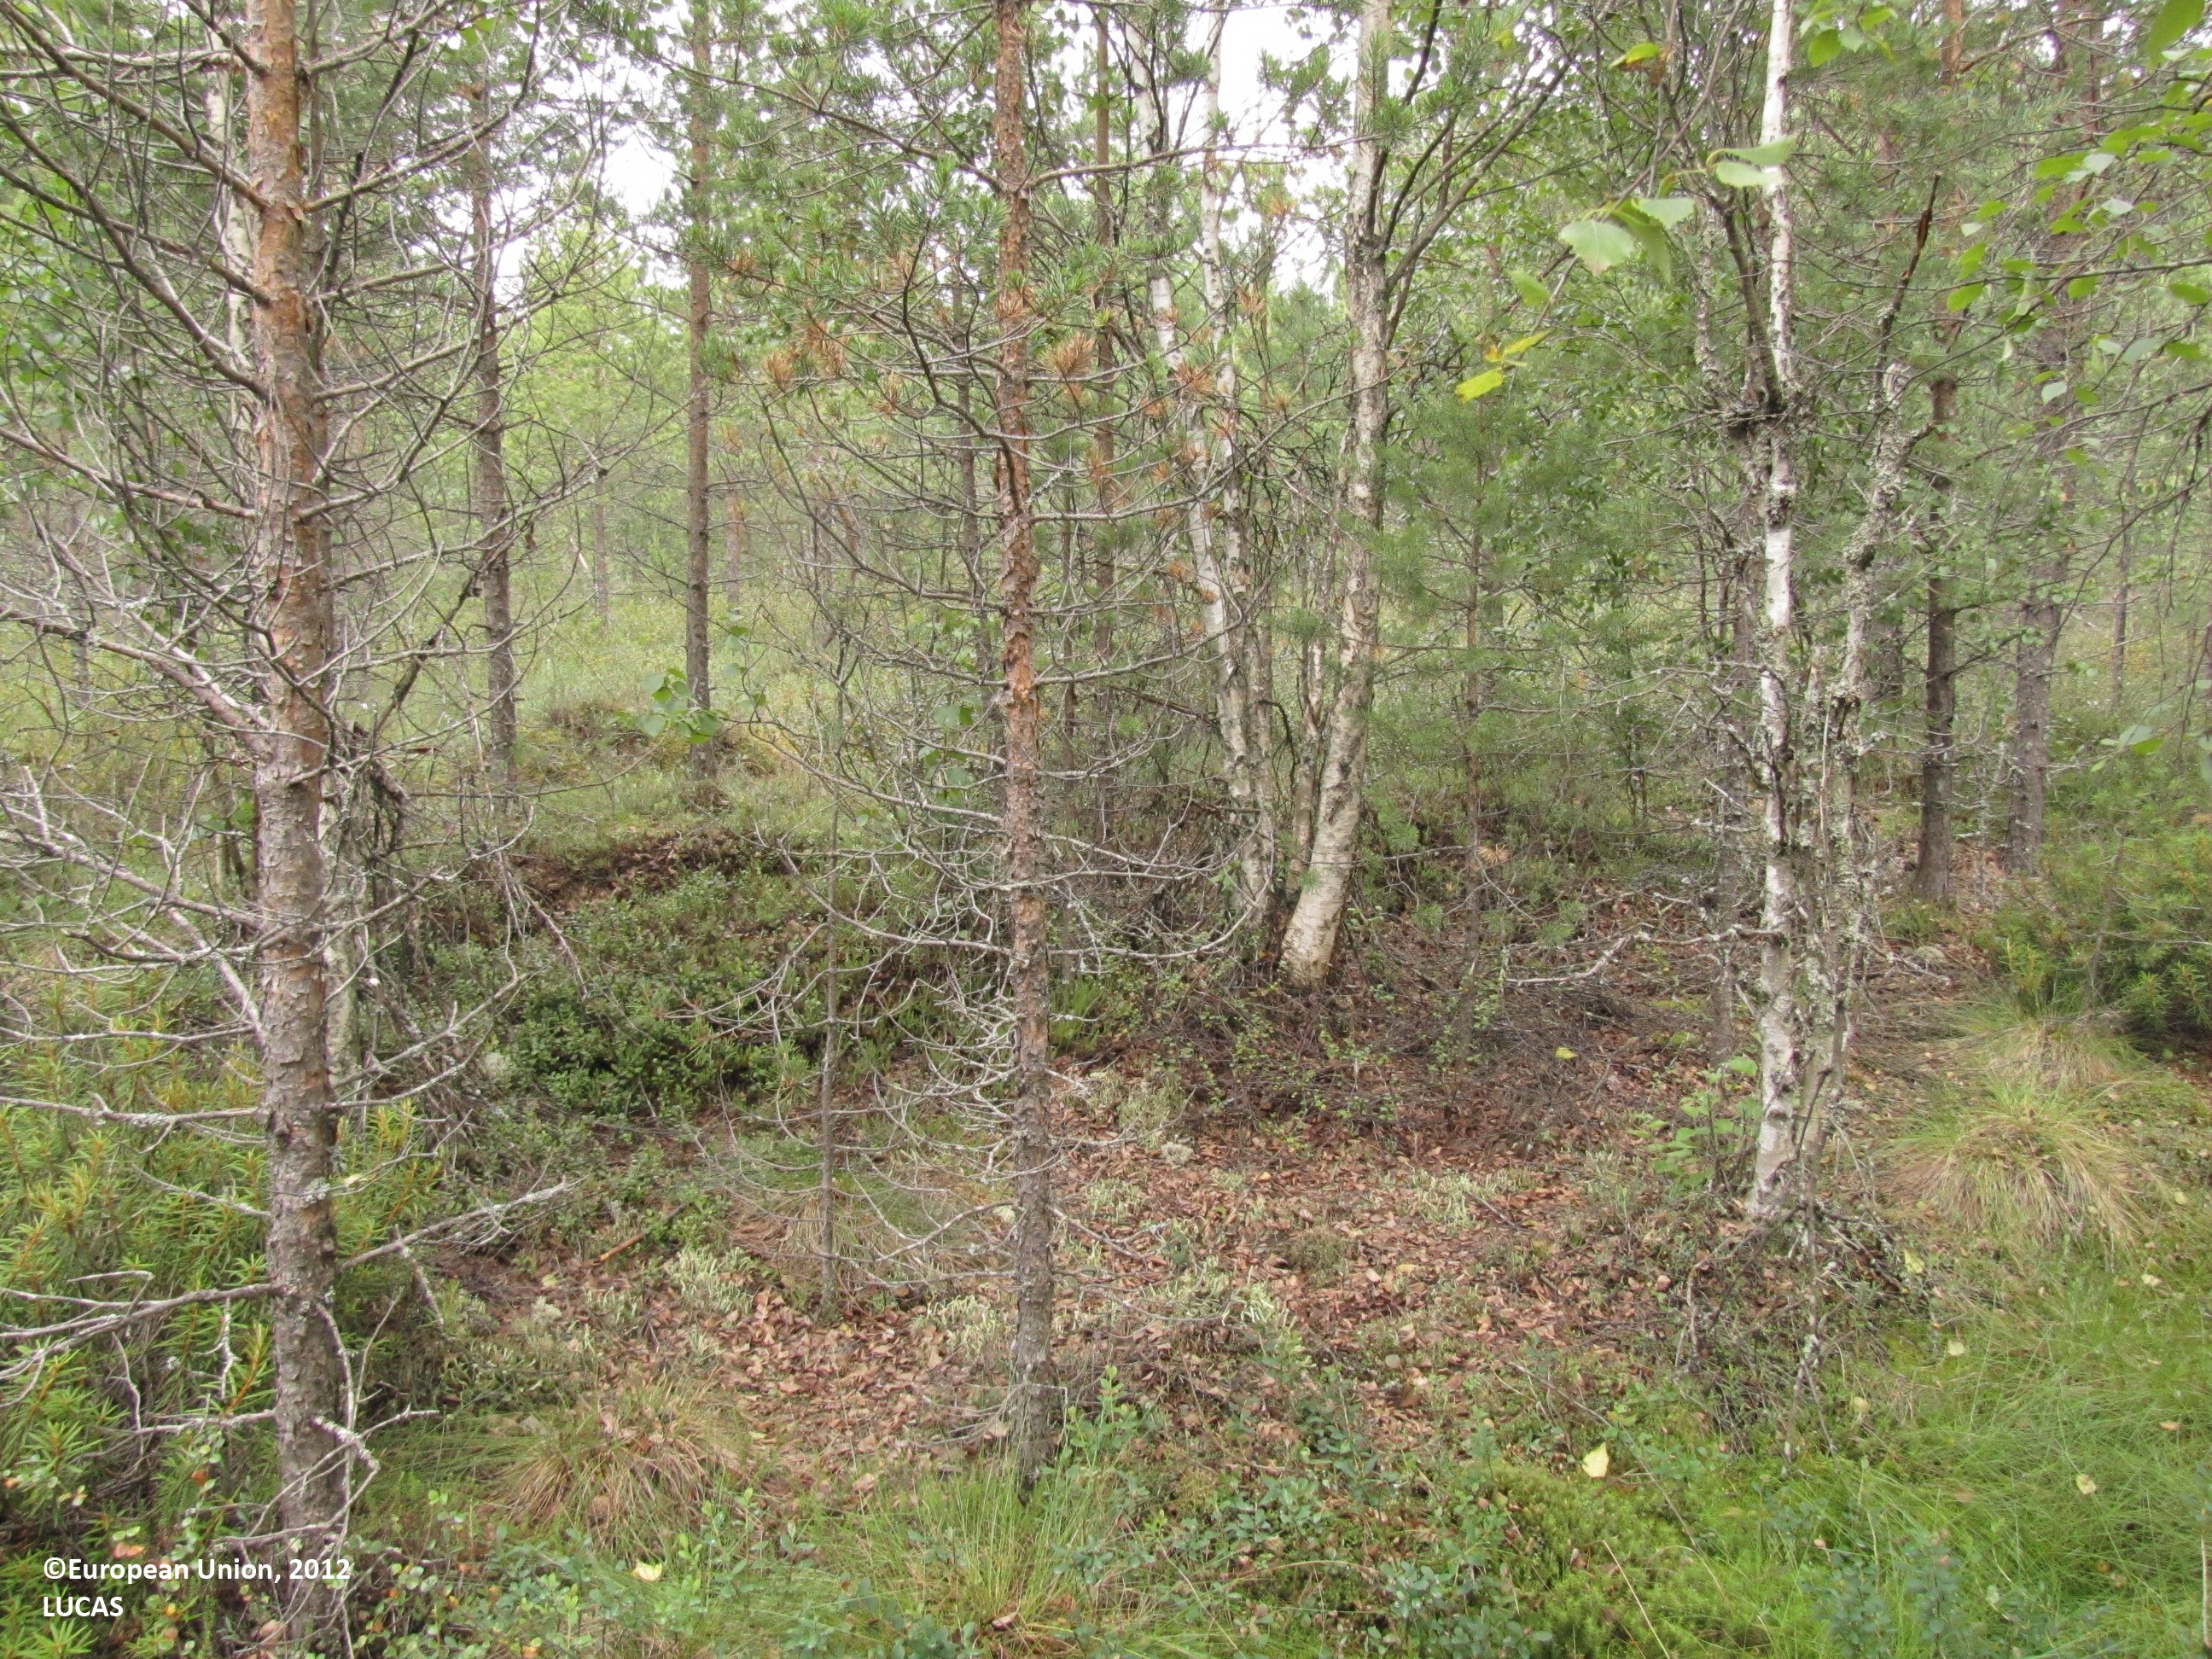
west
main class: Woodland
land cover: Pine dominated mixed woodland
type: mire and swamp forests
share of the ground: 25 - 50 %
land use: Forestry
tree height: > 5 m
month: July
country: FI
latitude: 62.2456
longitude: 23.0199
